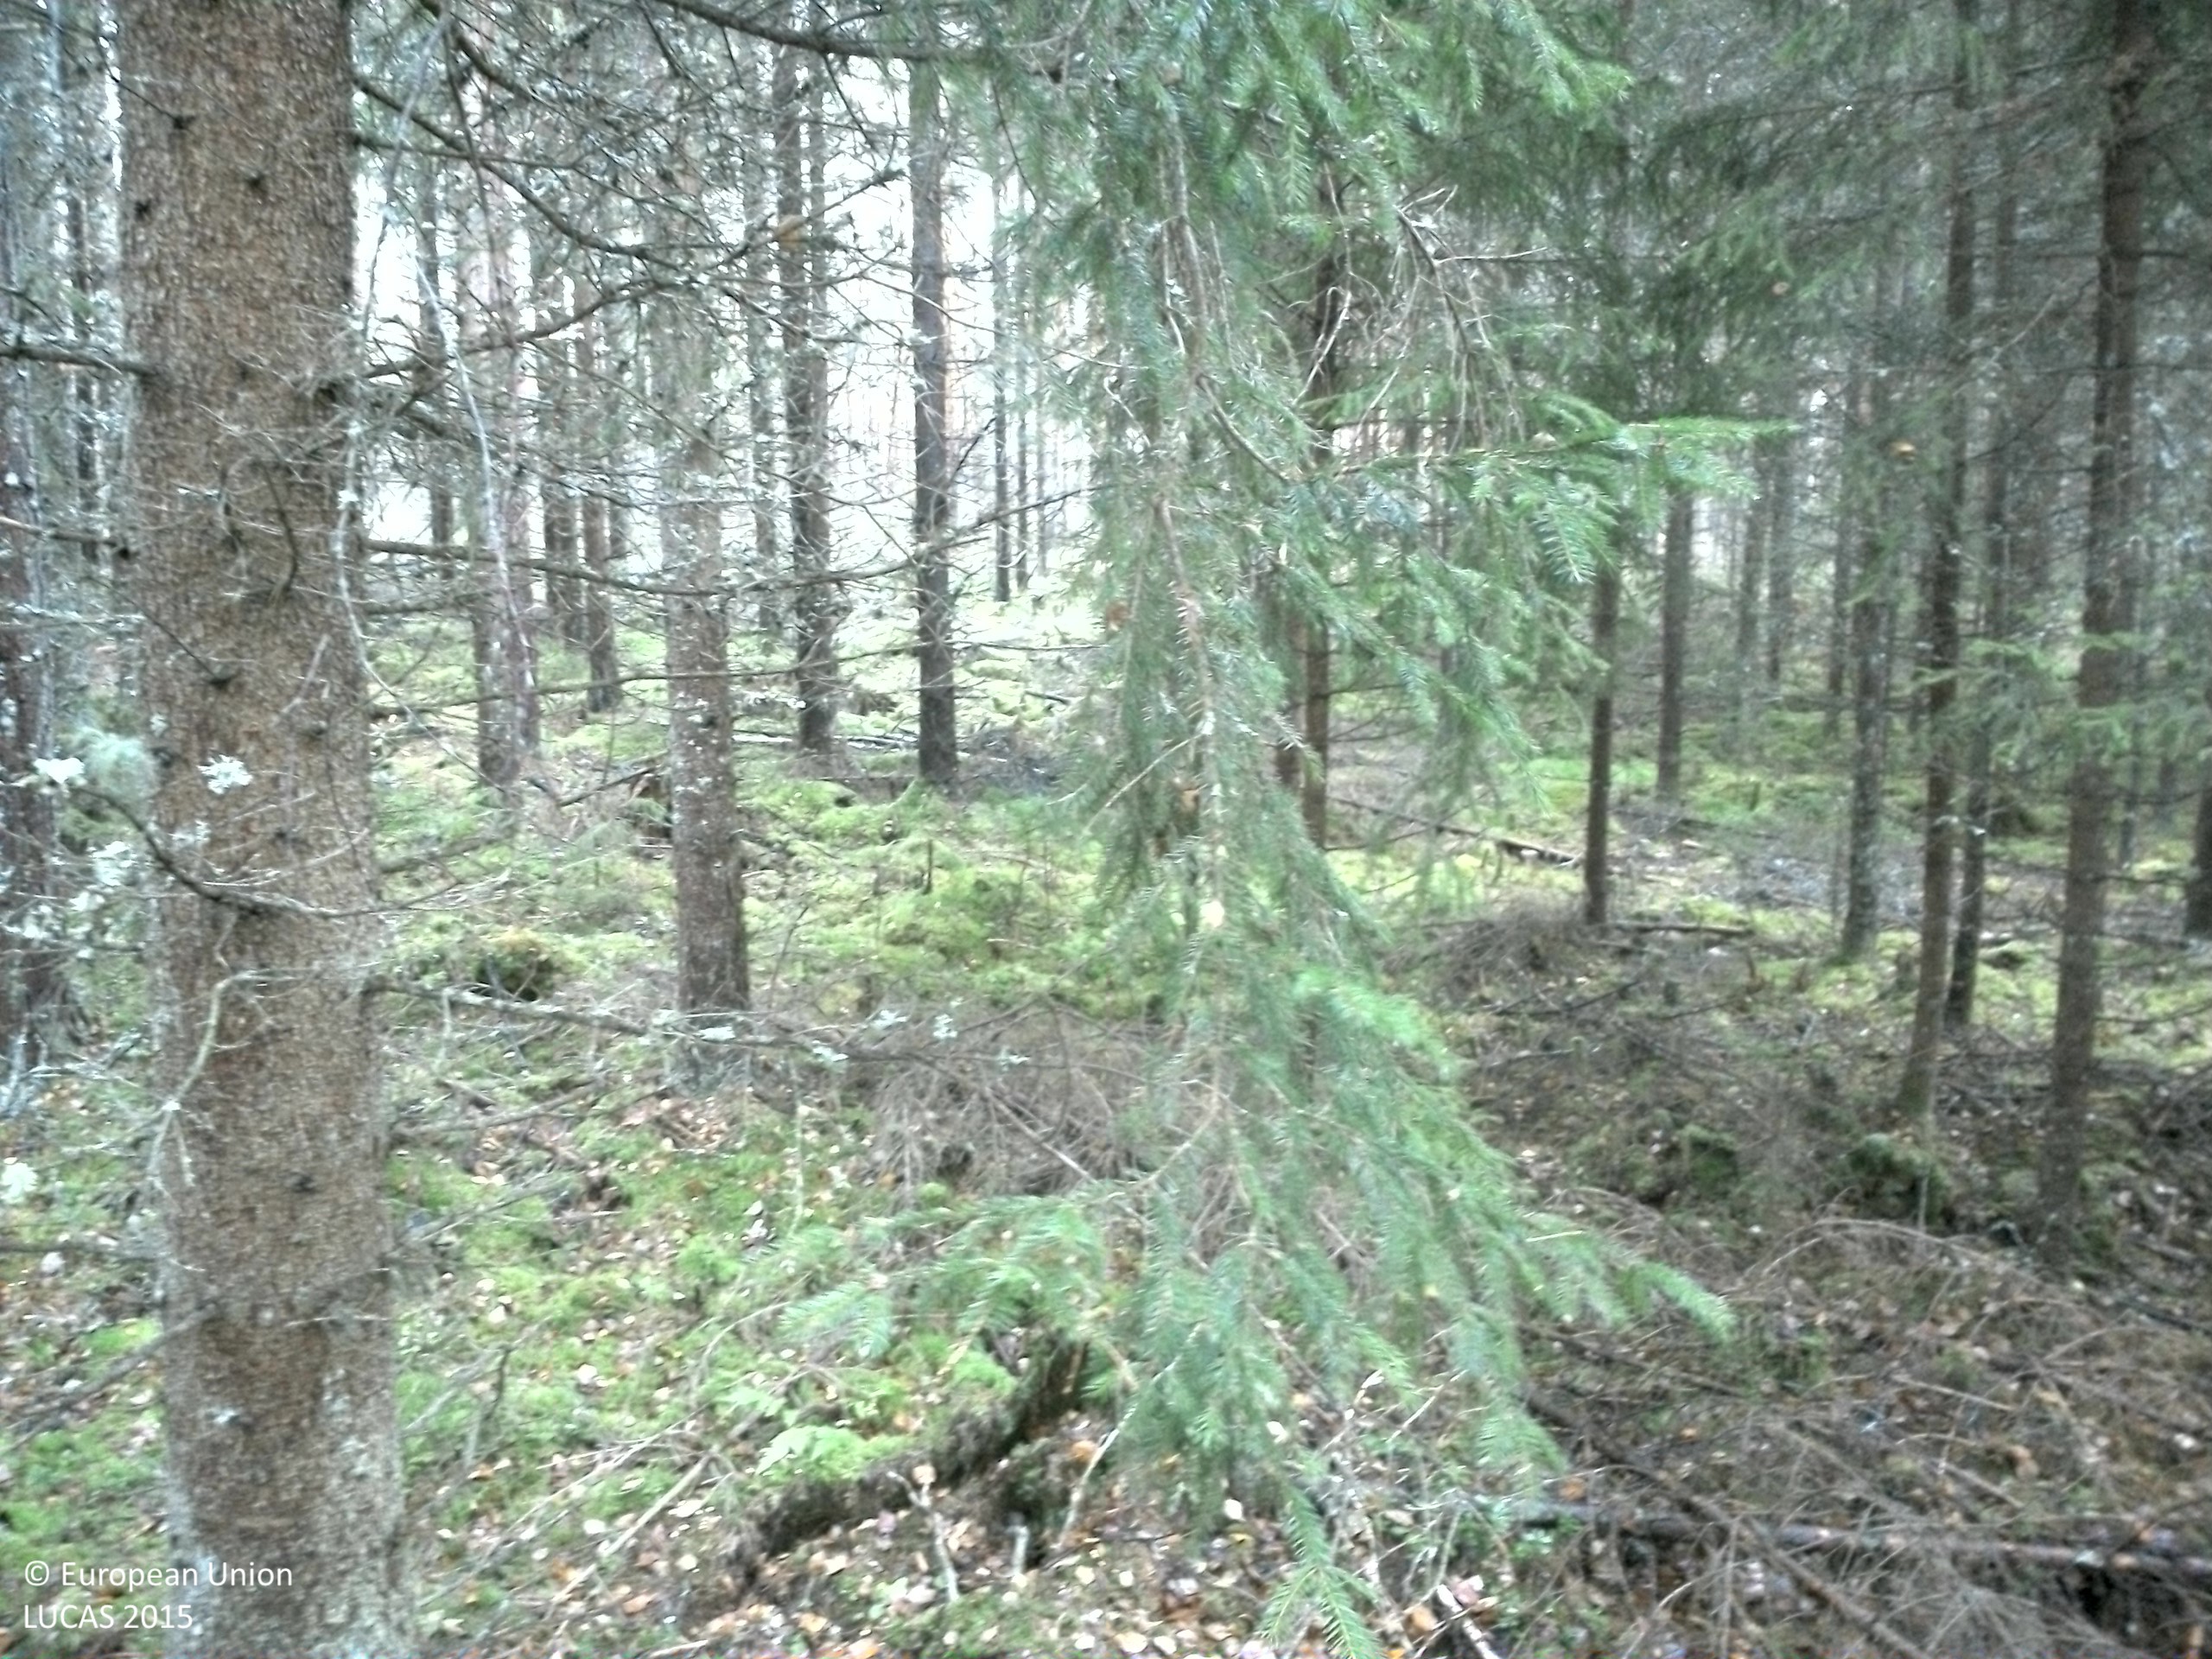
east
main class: Woodland
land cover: Spruce dominated mixed woodland
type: boreal forest
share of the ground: > 75 %
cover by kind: coniferous forest trees 55 %, broadleaved forest trees 20 %, shrubs 15 %, lichens and mosses 10 %
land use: Forestry
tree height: > 5 m
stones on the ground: < 10 %
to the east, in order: Spruce dominated mixed woodland; Tracks; Spruce dominated coniferous woodland; Tracks; Pine dominated coniferous woodland; Other coniferous woodland; Spruce dominated coniferous woodland
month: October
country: SE
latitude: 59.7212
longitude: 14.7733
